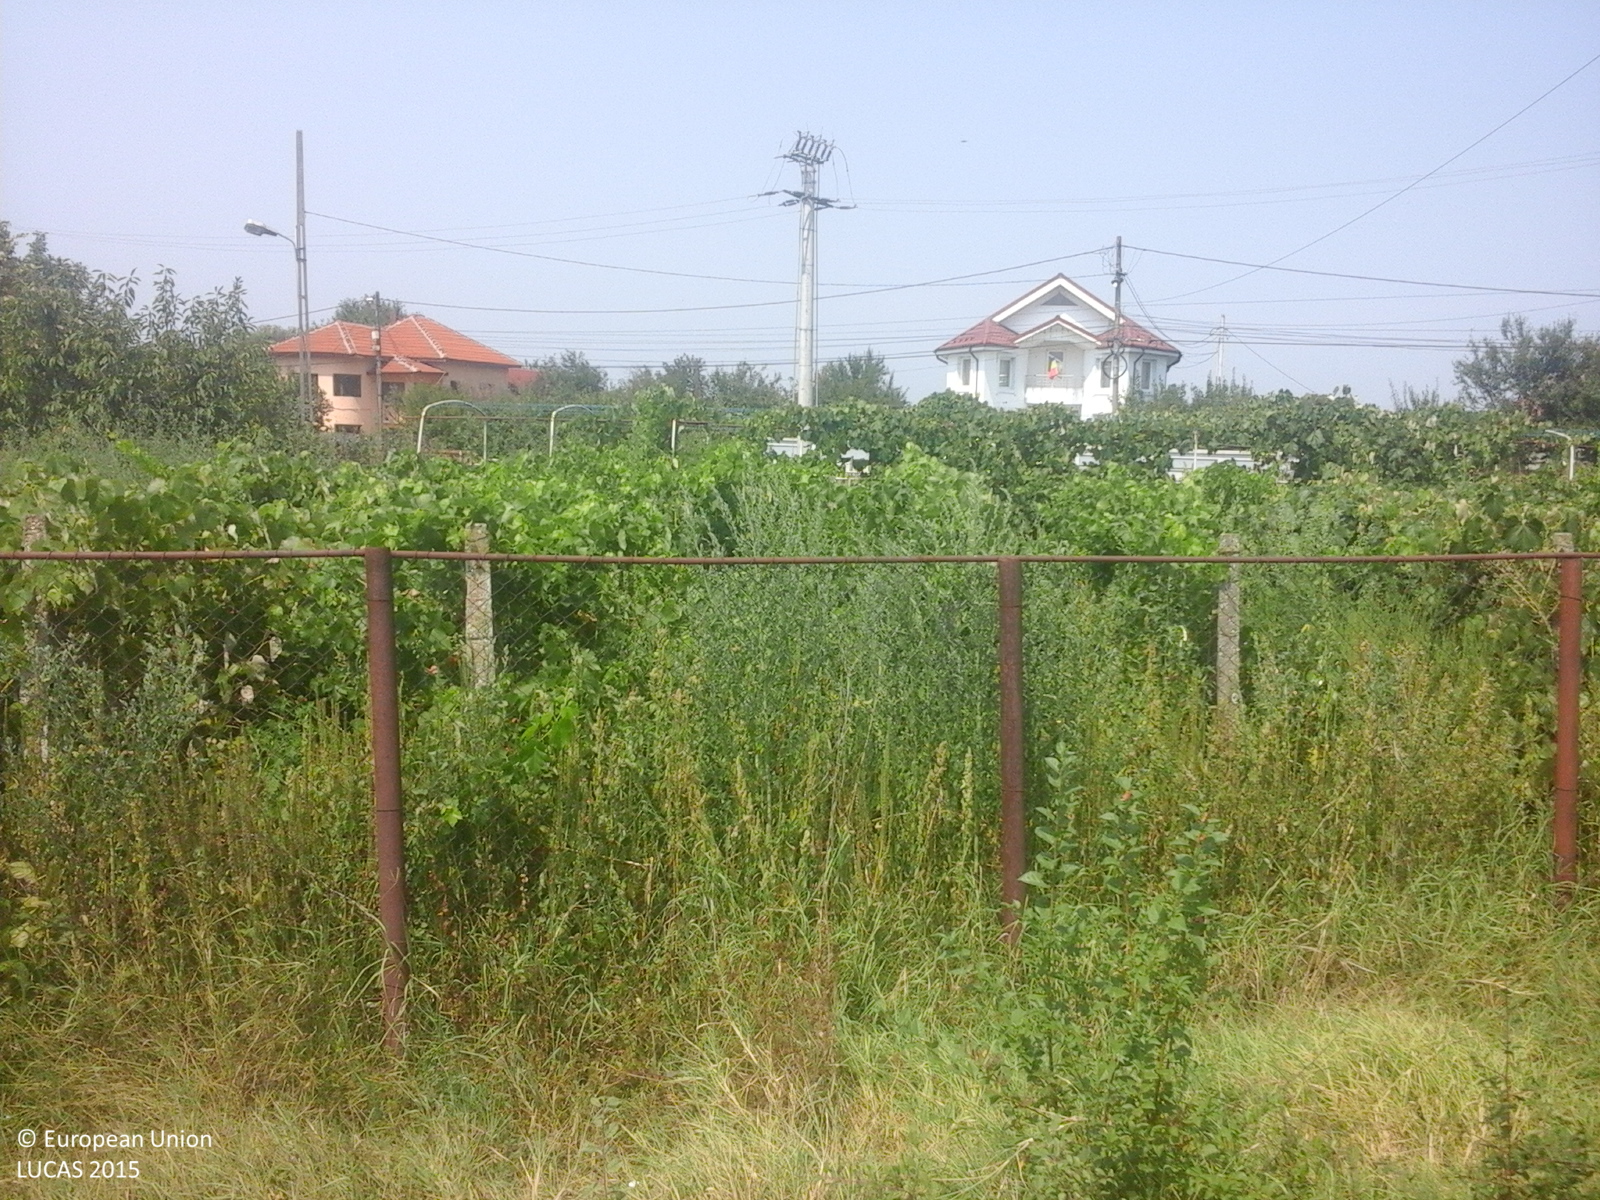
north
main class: Cropland
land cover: Vineyards
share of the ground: > 75 %
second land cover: Grassland without tree/shrub cover
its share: 10 - 25 %
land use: Agriculture (excluding fallow land and kitchen gardens)
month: August
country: RO
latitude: 44.2644
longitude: 23.7980
